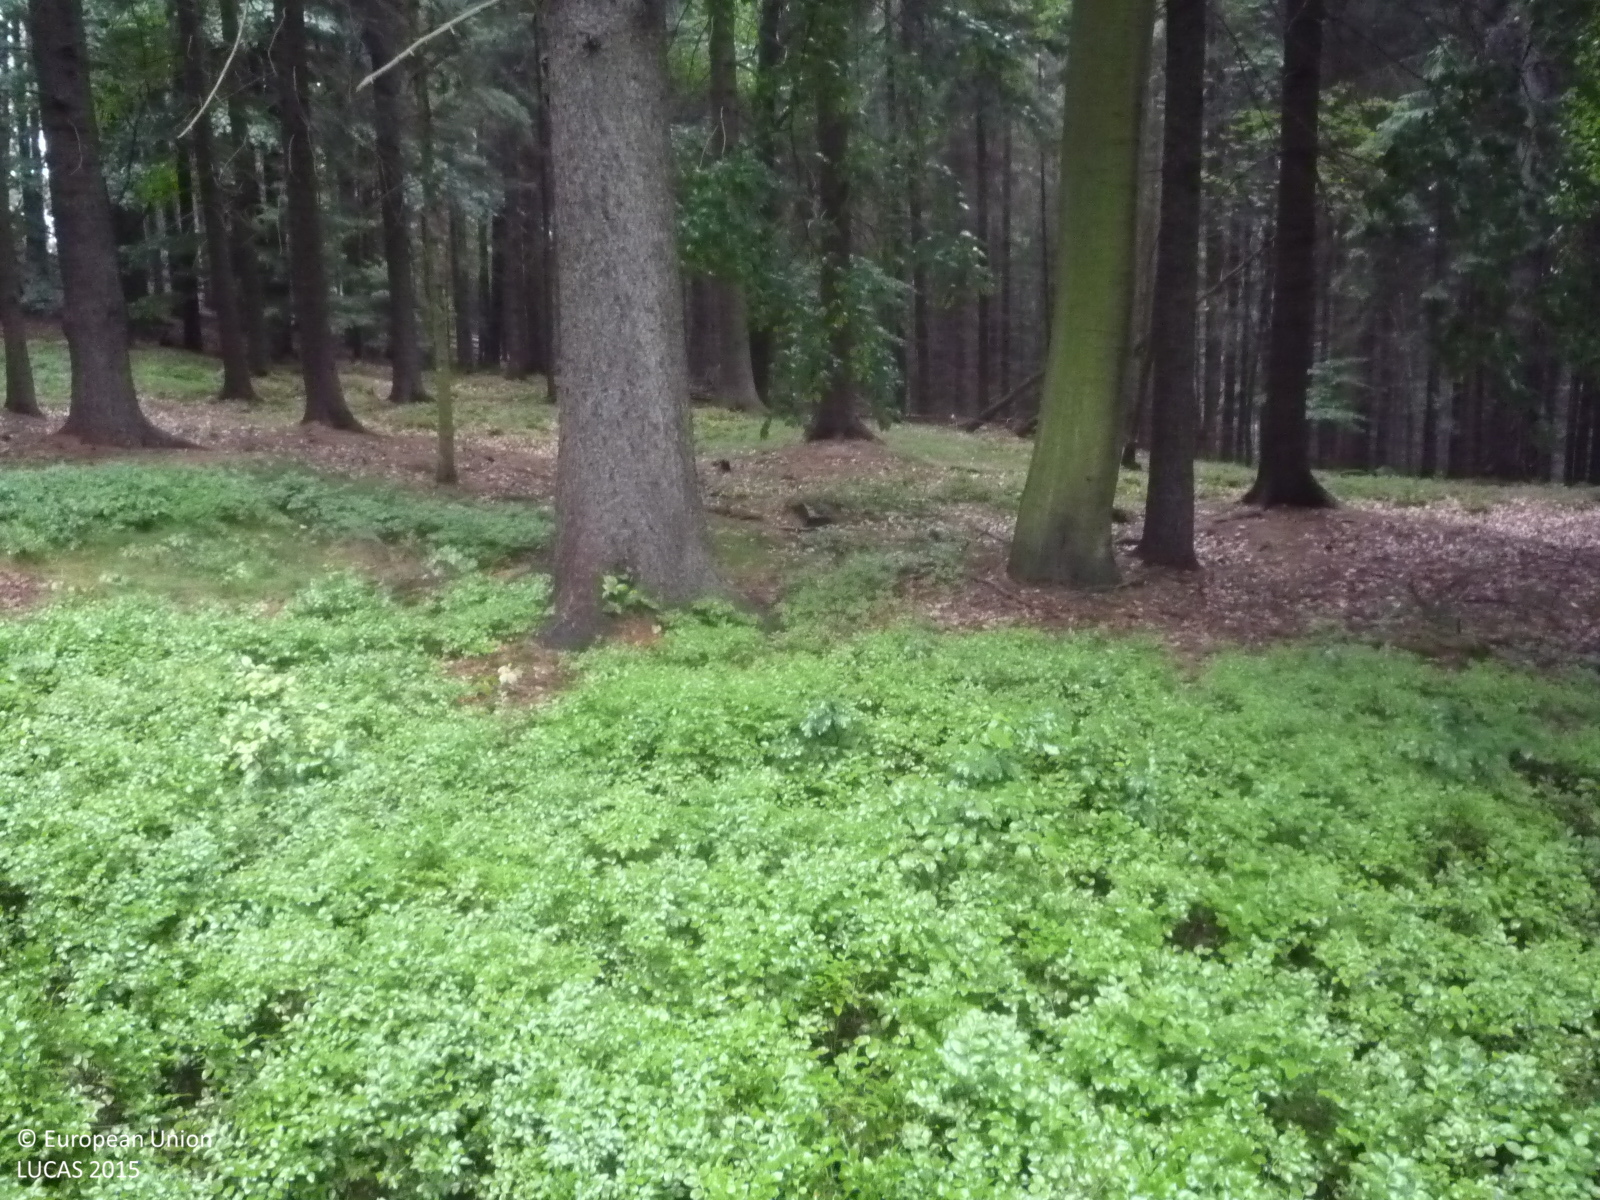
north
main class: Woodland
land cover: Spruce dominated coniferous woodland
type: hemiboreal forest and nemoral coniferous forest and mixed broadleaved-coniferous forest
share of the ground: > 75 %
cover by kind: coniferous forest trees 70 %, herbaceous plants 15 %, unconsolidated bare surface 10 %, broadleaved forest trees 5 %
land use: Forestry
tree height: > 5 m
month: July
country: CZ
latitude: 50.4365
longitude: 15.7352
